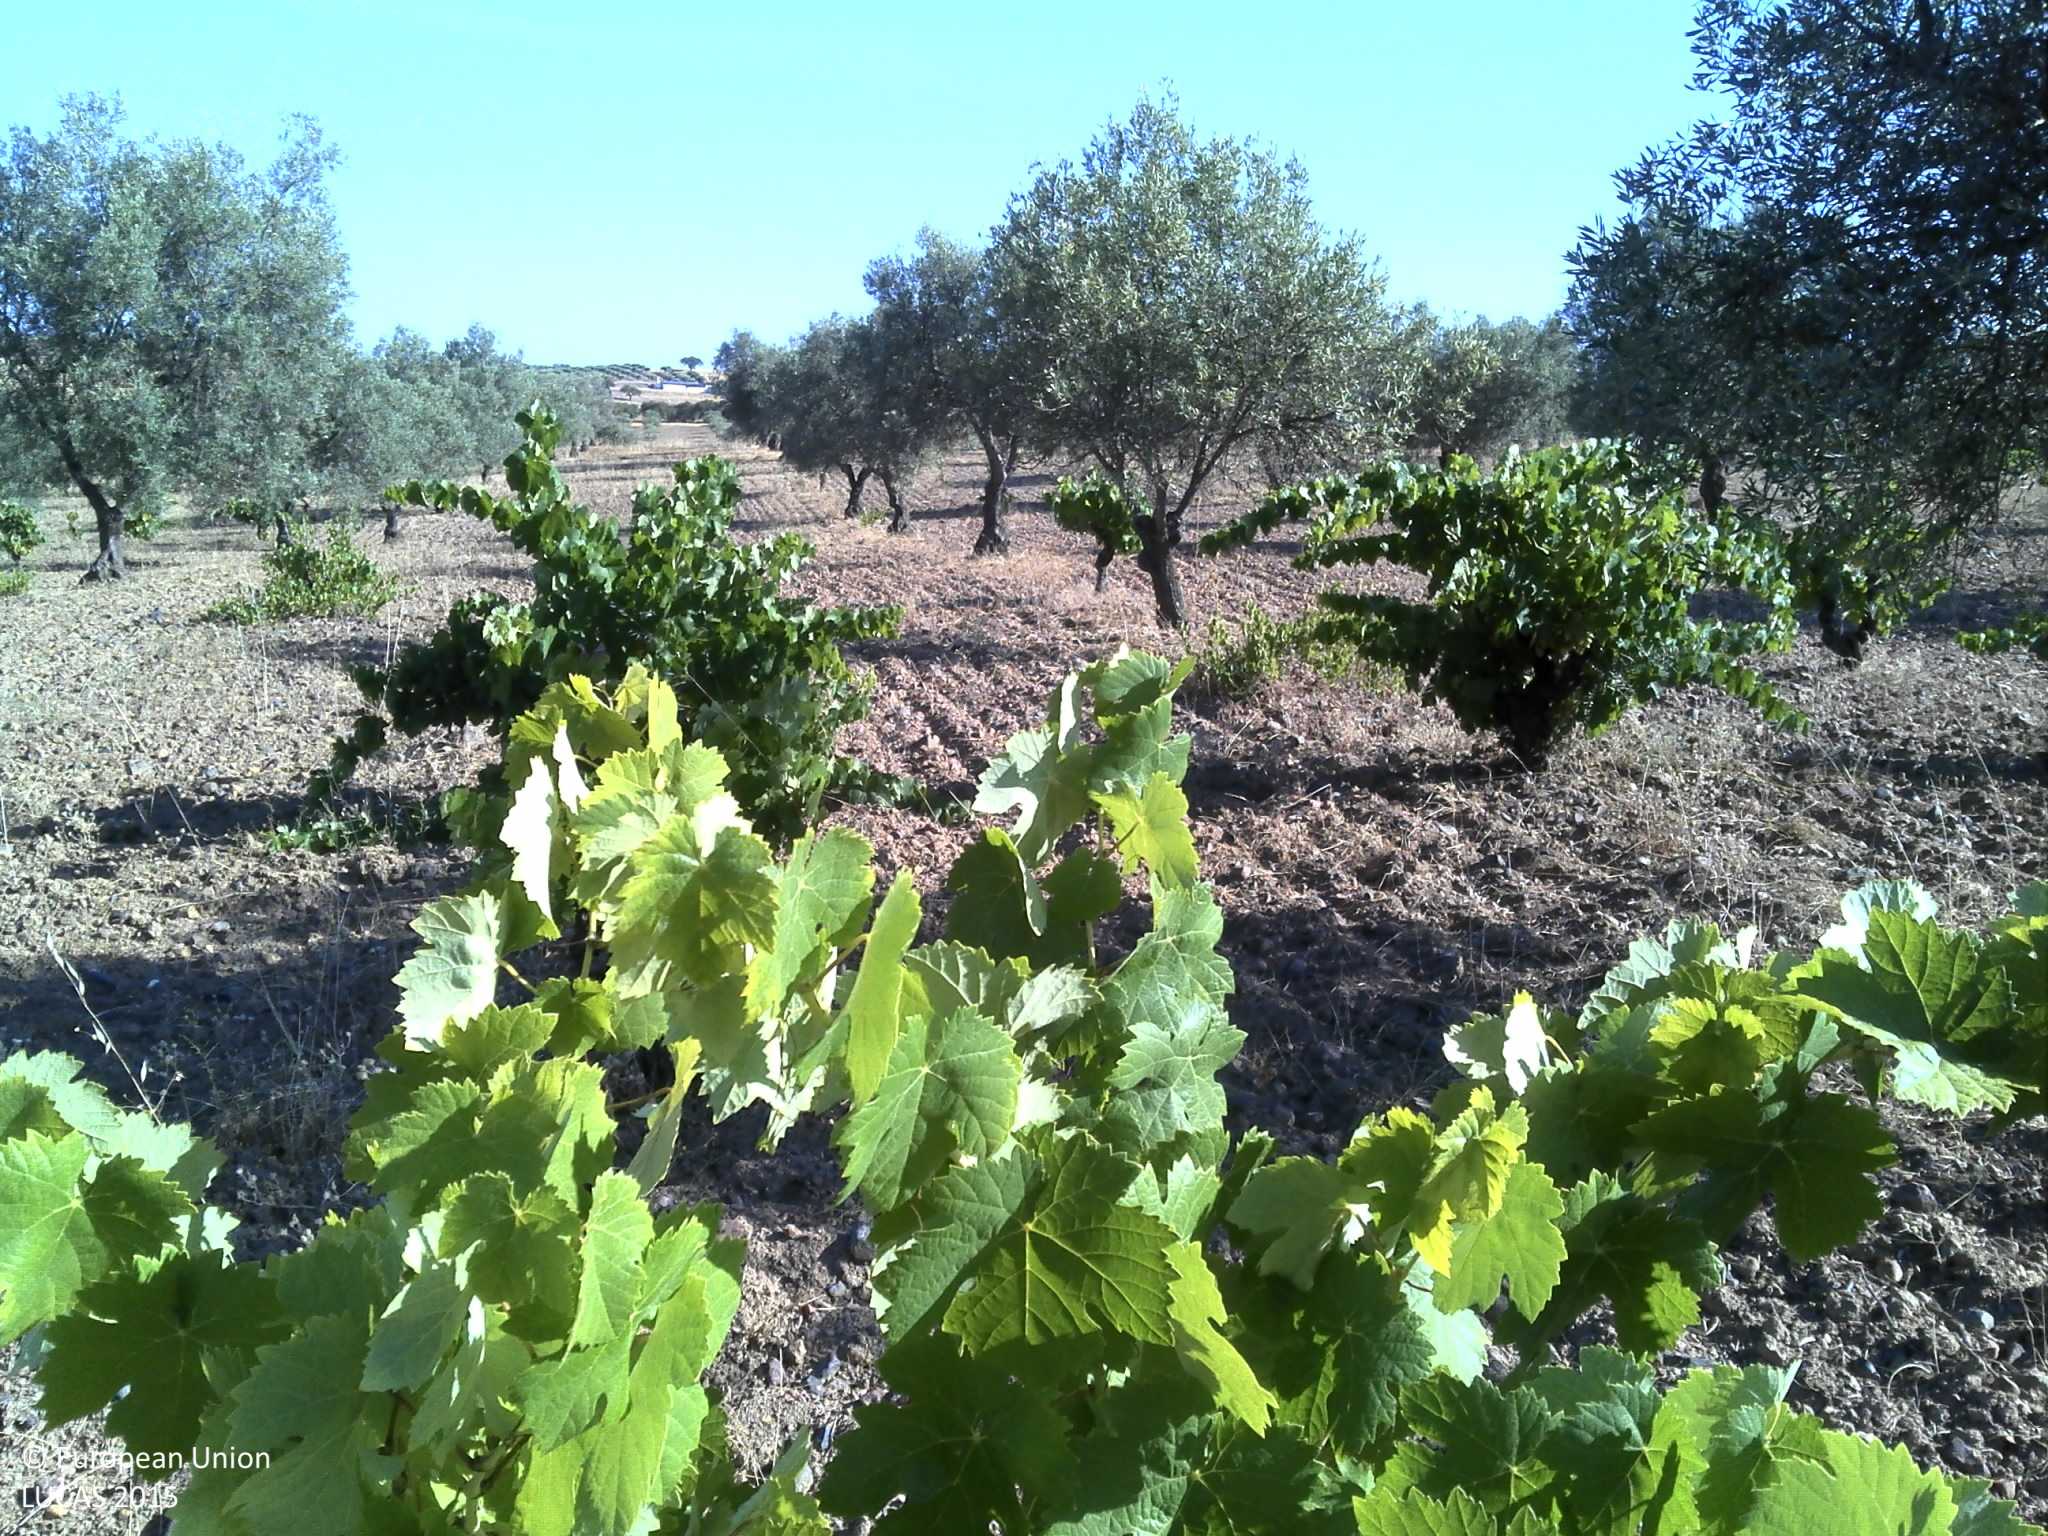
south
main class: Cropland
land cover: Olive groves
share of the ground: 25 - 50 %
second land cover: Vineyards
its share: 25 - 50 %
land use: Agriculture (excluding fallow land and kitchen gardens)
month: July
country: PT
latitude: 38.2309
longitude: -7.2335
